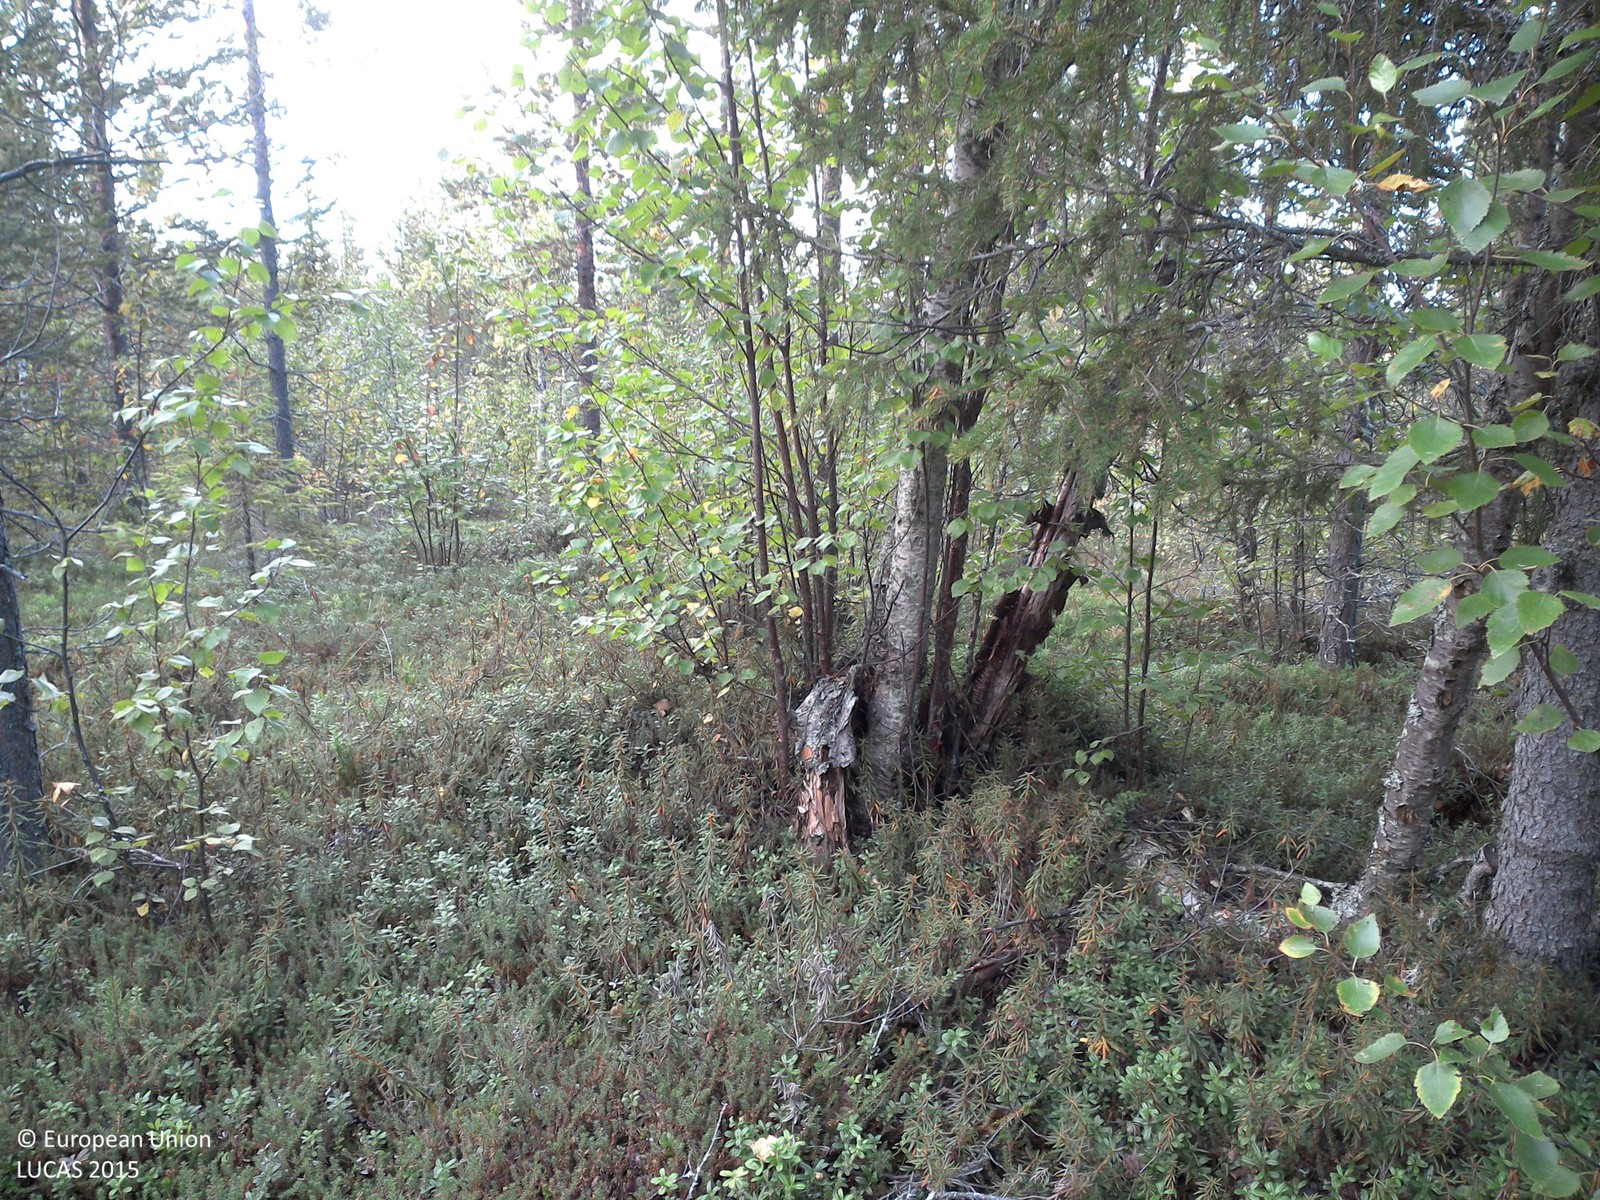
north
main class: Woodland
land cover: Pine dominated mixed woodland
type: boreal forest
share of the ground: 25 - 50 %
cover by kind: shrubs 55 %, coniferous forest trees 30 %, broadleaved forest trees 10 %, lichens and mosses 5 %
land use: Forestry
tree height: > 5 m
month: August
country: SE
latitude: 68.0719
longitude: 23.2748
